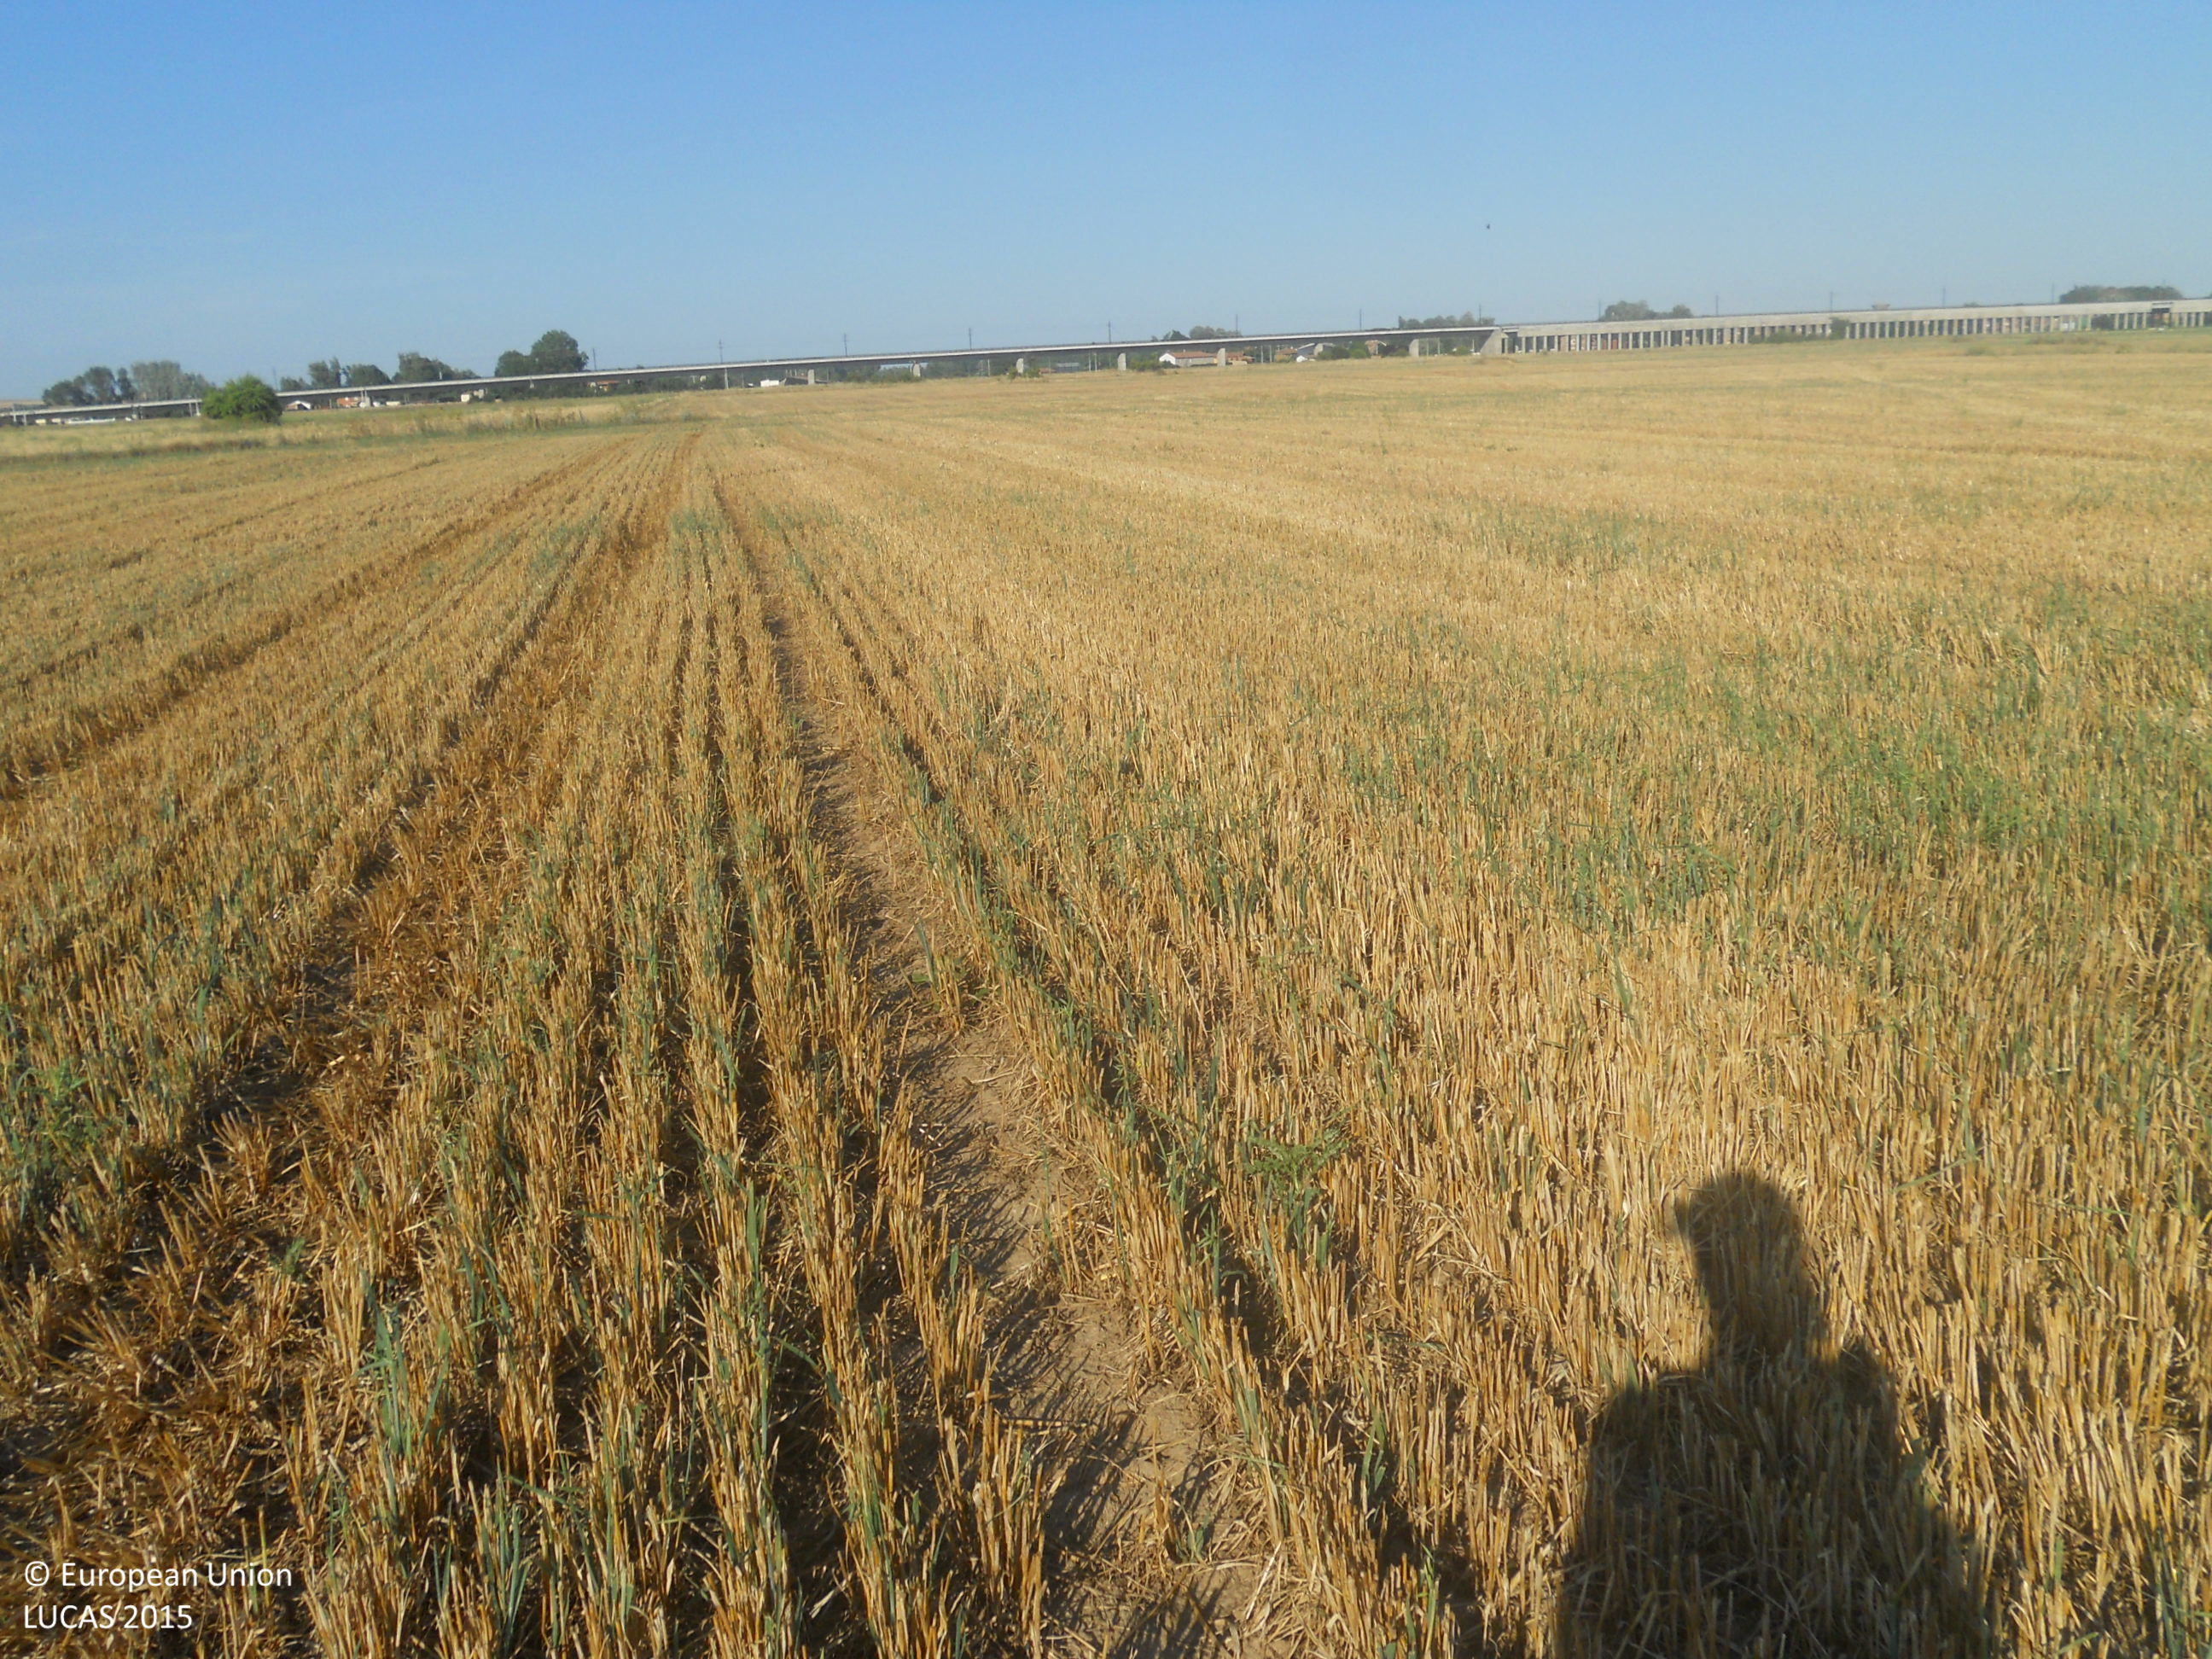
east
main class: Cropland
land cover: Oats
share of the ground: > 75 %
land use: Agriculture (excluding fallow land and kitchen gardens)
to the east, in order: Oats
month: July
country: ES
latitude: 42.5070
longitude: -5.5638
